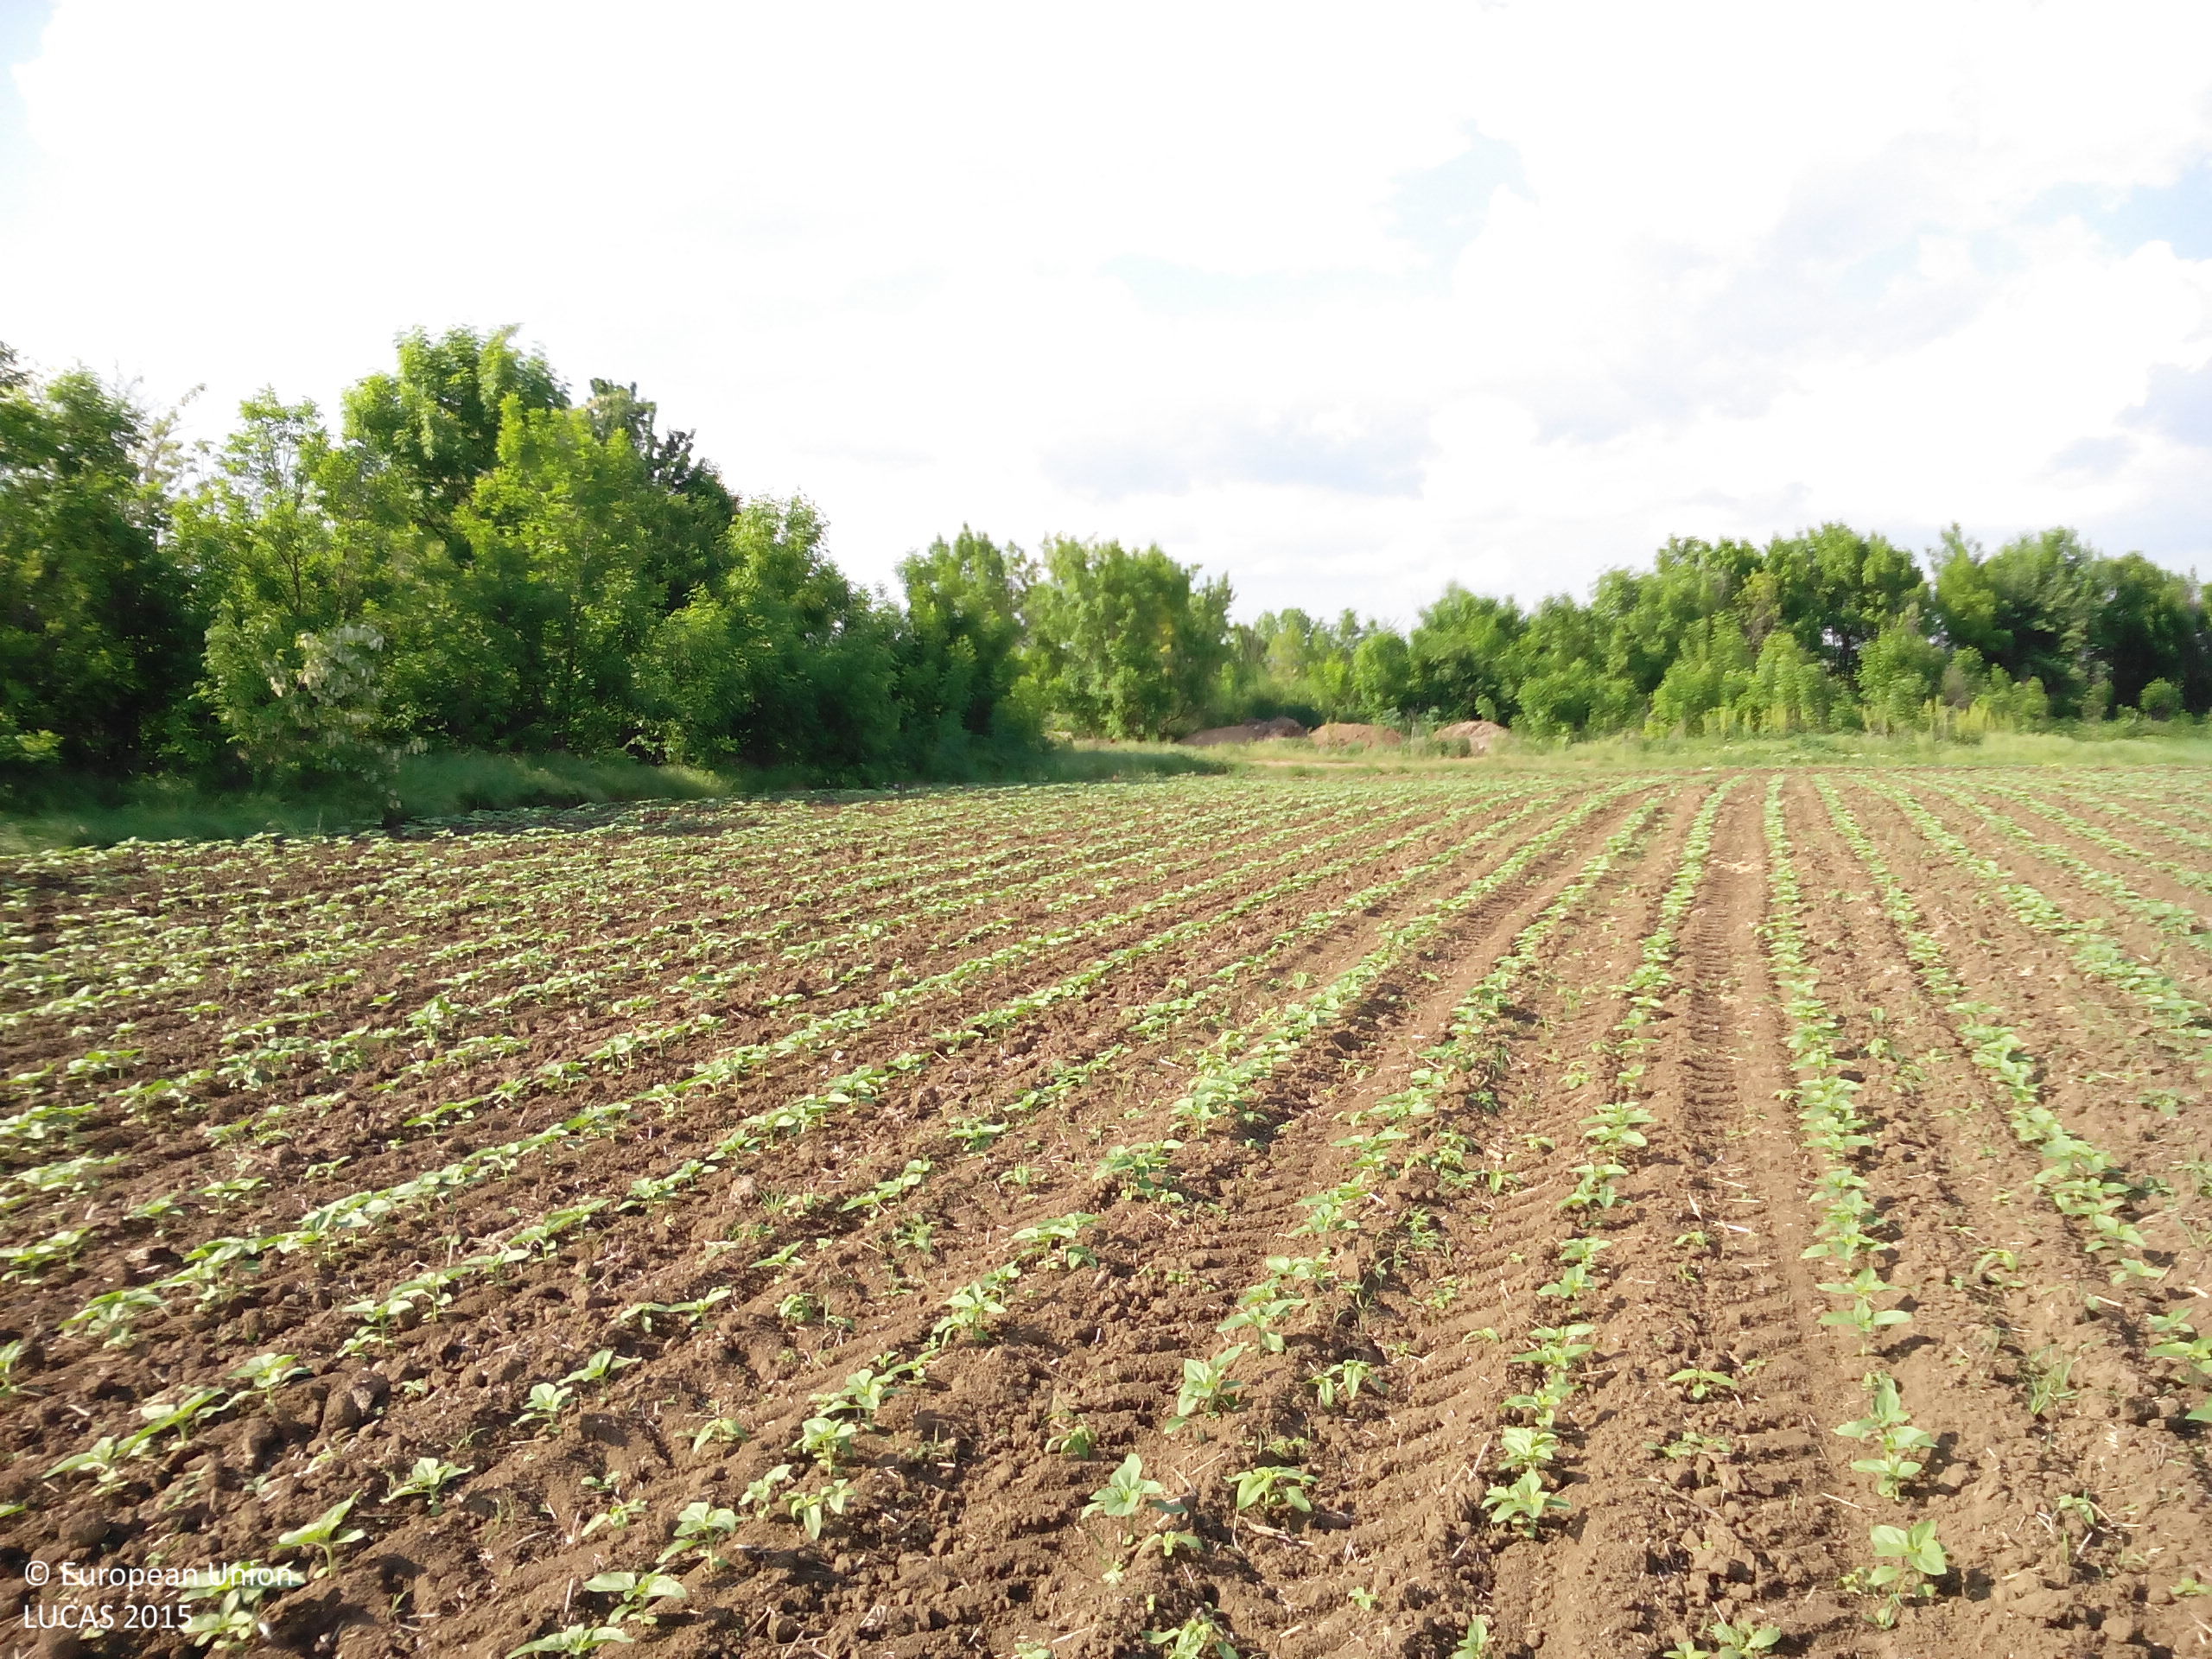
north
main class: Cropland
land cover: Sunflower
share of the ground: 10 - 25 %
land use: Agriculture (excluding fallow land and kitchen gardens)
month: May
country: BG
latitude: 43.5511
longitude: 23.8018
